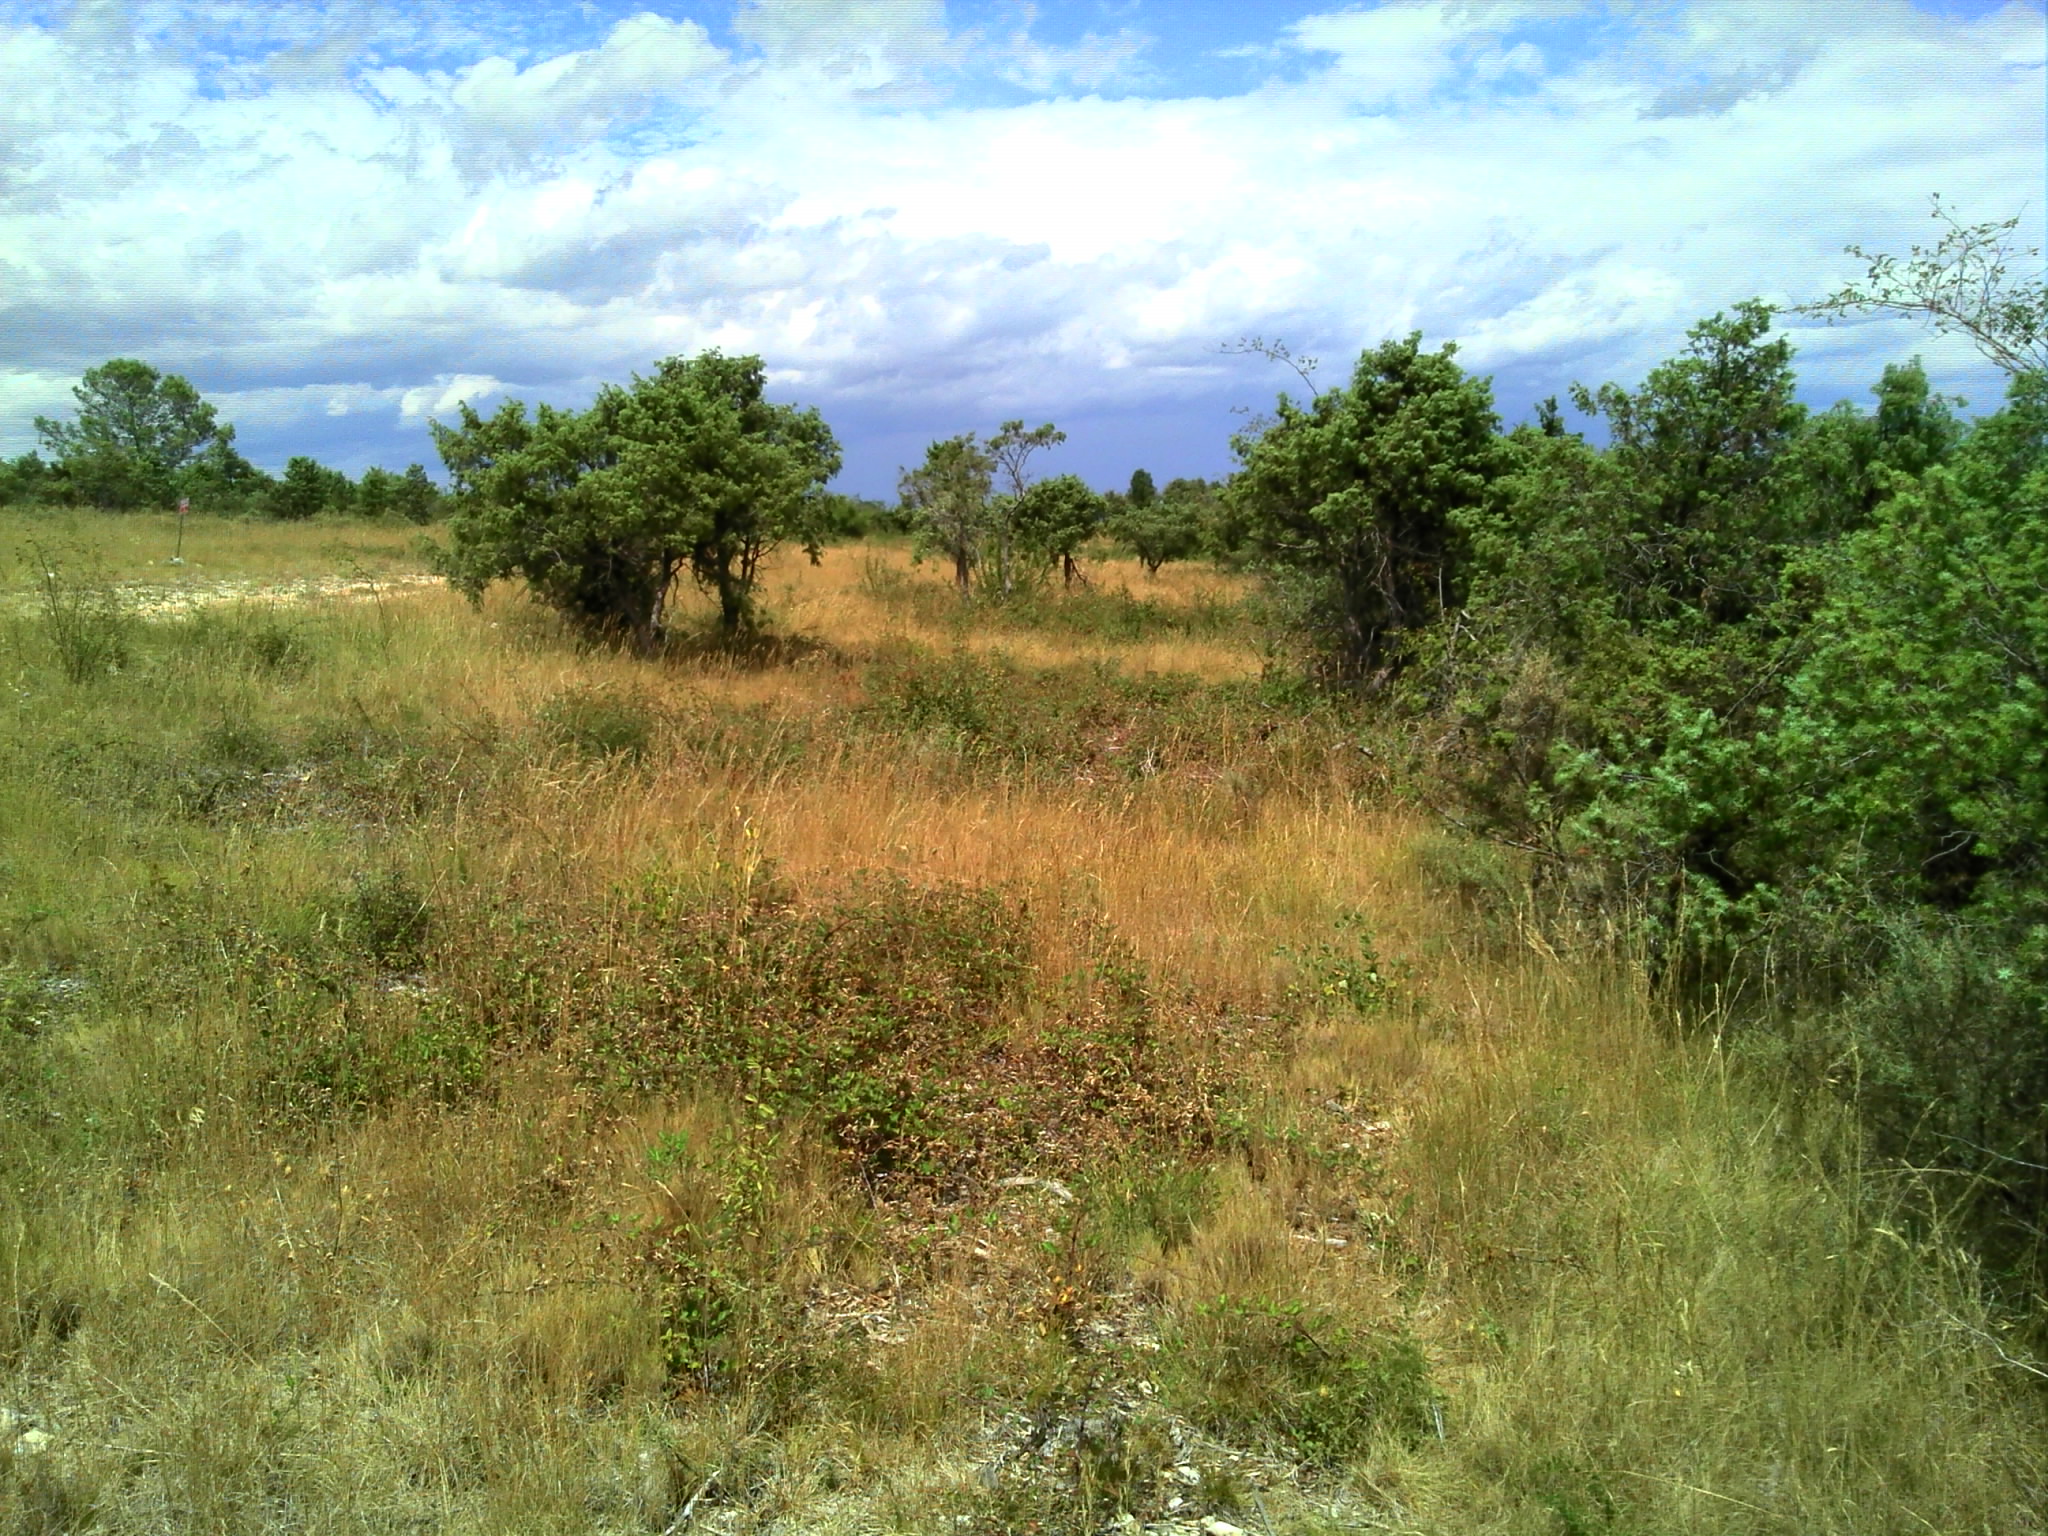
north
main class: Shrubland
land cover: Shrubland with sparse tree cover
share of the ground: > 75 %
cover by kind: shrubs 45 %, herbaceous plants 30 %, consolidated bare surface 20 %, coniferous forest trees 5 %
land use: Semi-natural and natural areas not in use
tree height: < 5 m
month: July
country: FR
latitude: 44.1241
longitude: 4.3467
